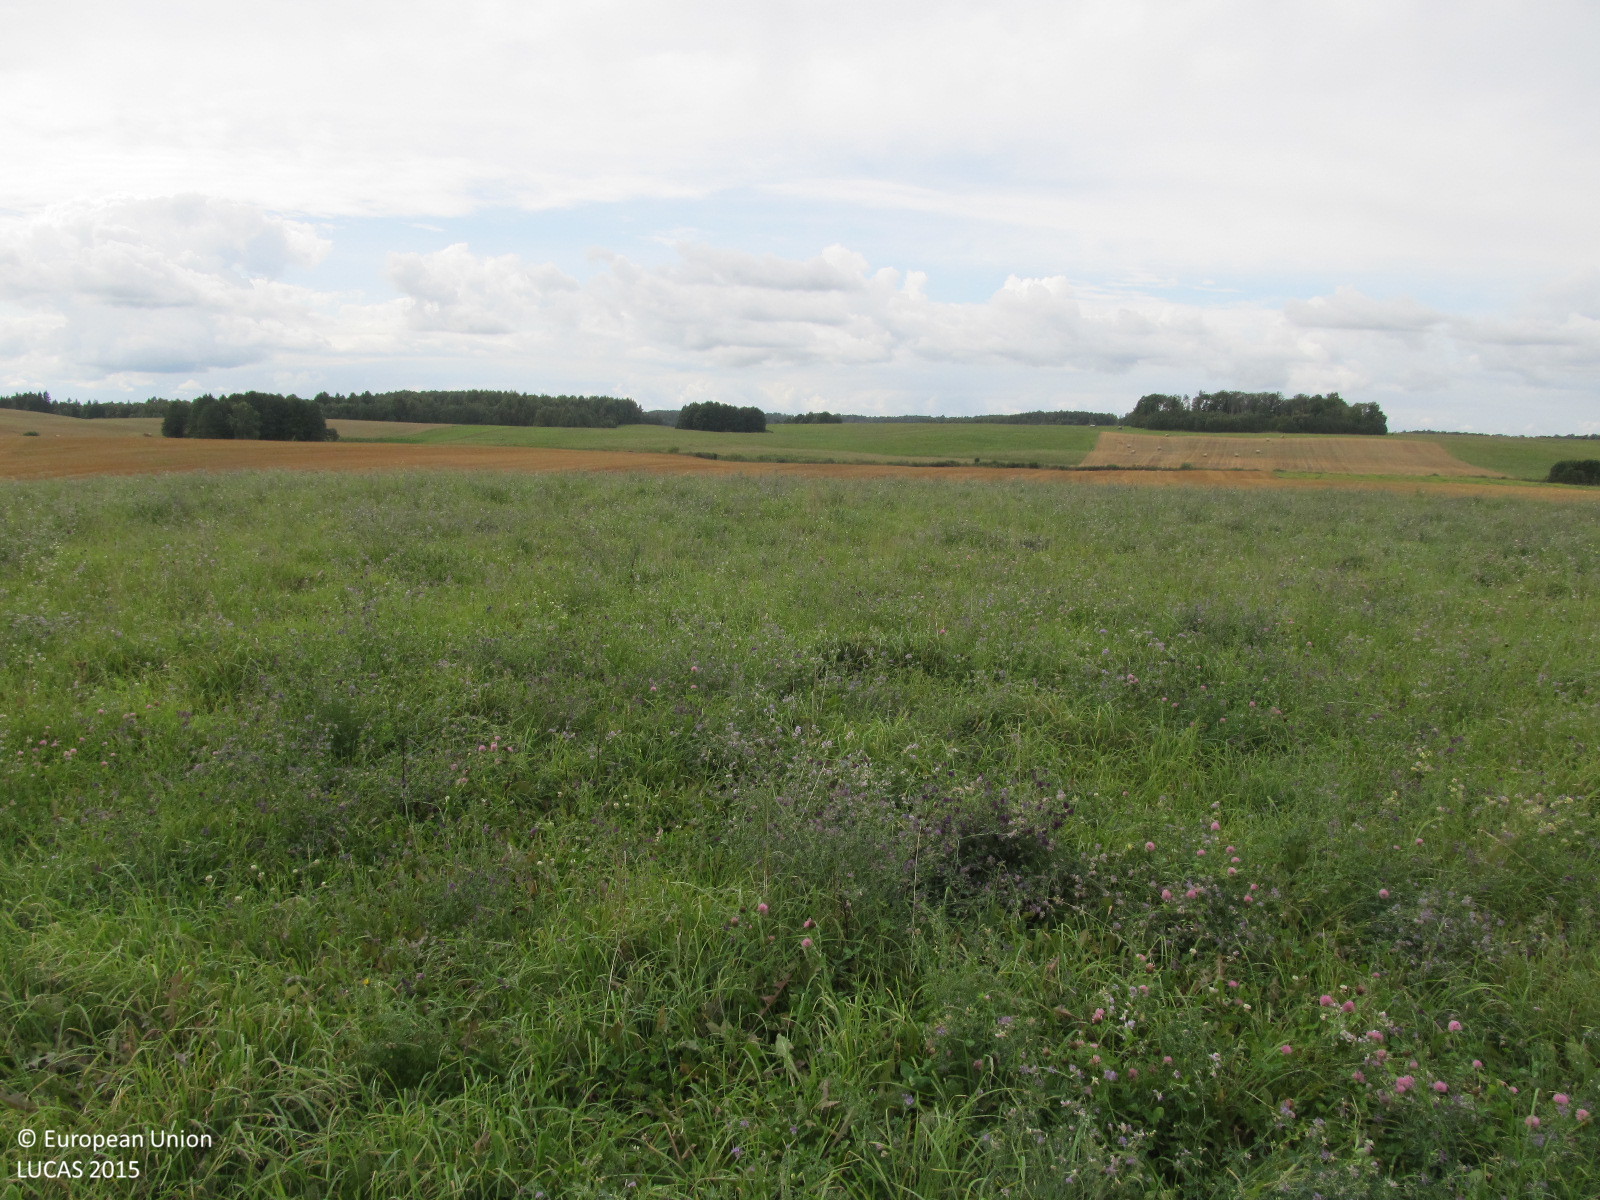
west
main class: Grassland
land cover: Grassland without tree/shrub cover
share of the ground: > 75 %
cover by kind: herbaceous plants 100 %
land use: Agriculture (excluding fallow land and kitchen gardens)
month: September
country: LT
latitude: 55.7043
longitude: 22.6502
